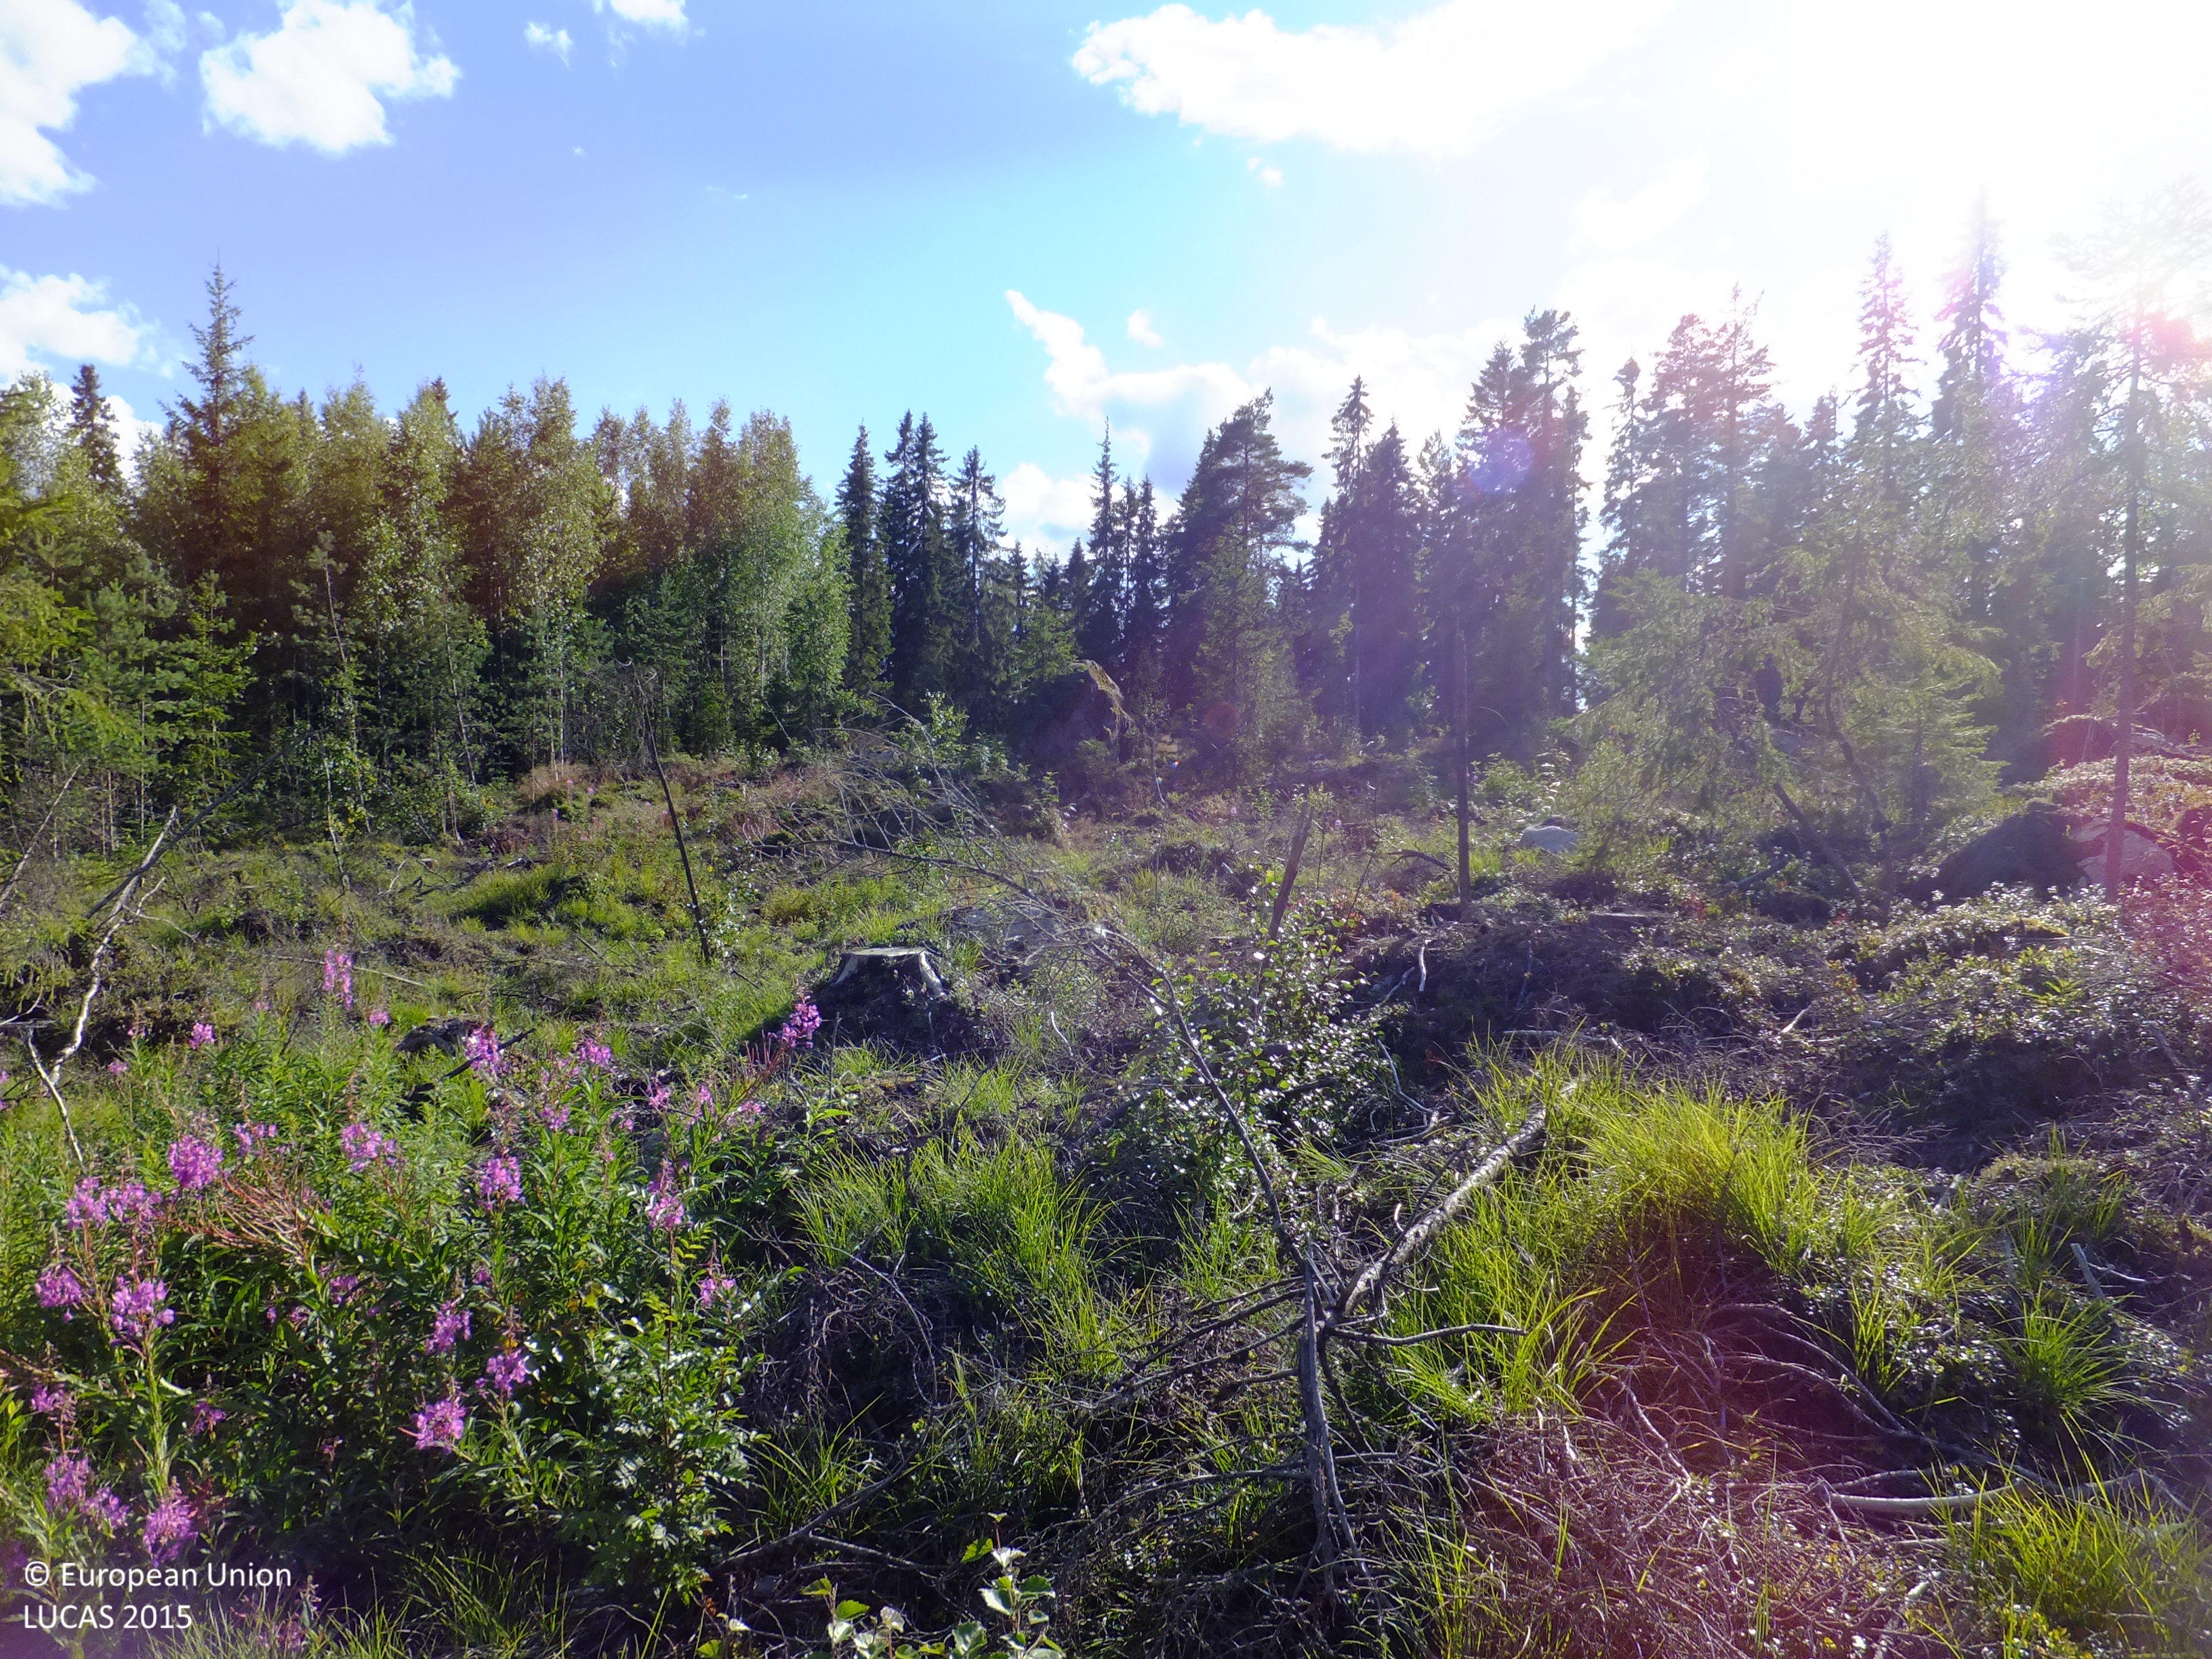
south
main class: Shrubland
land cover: Shrubland with sparse tree cover
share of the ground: > 75 %
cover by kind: herbaceous plants 40 %, unconsolidated bare surface 25 %, consolidated bare surface 20 %, shrubs 10 %, coniferous forest trees 5 %
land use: Forestry
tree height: < 5 m
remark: Clear cut
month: August
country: FI
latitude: 63.1351
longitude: 22.6881
